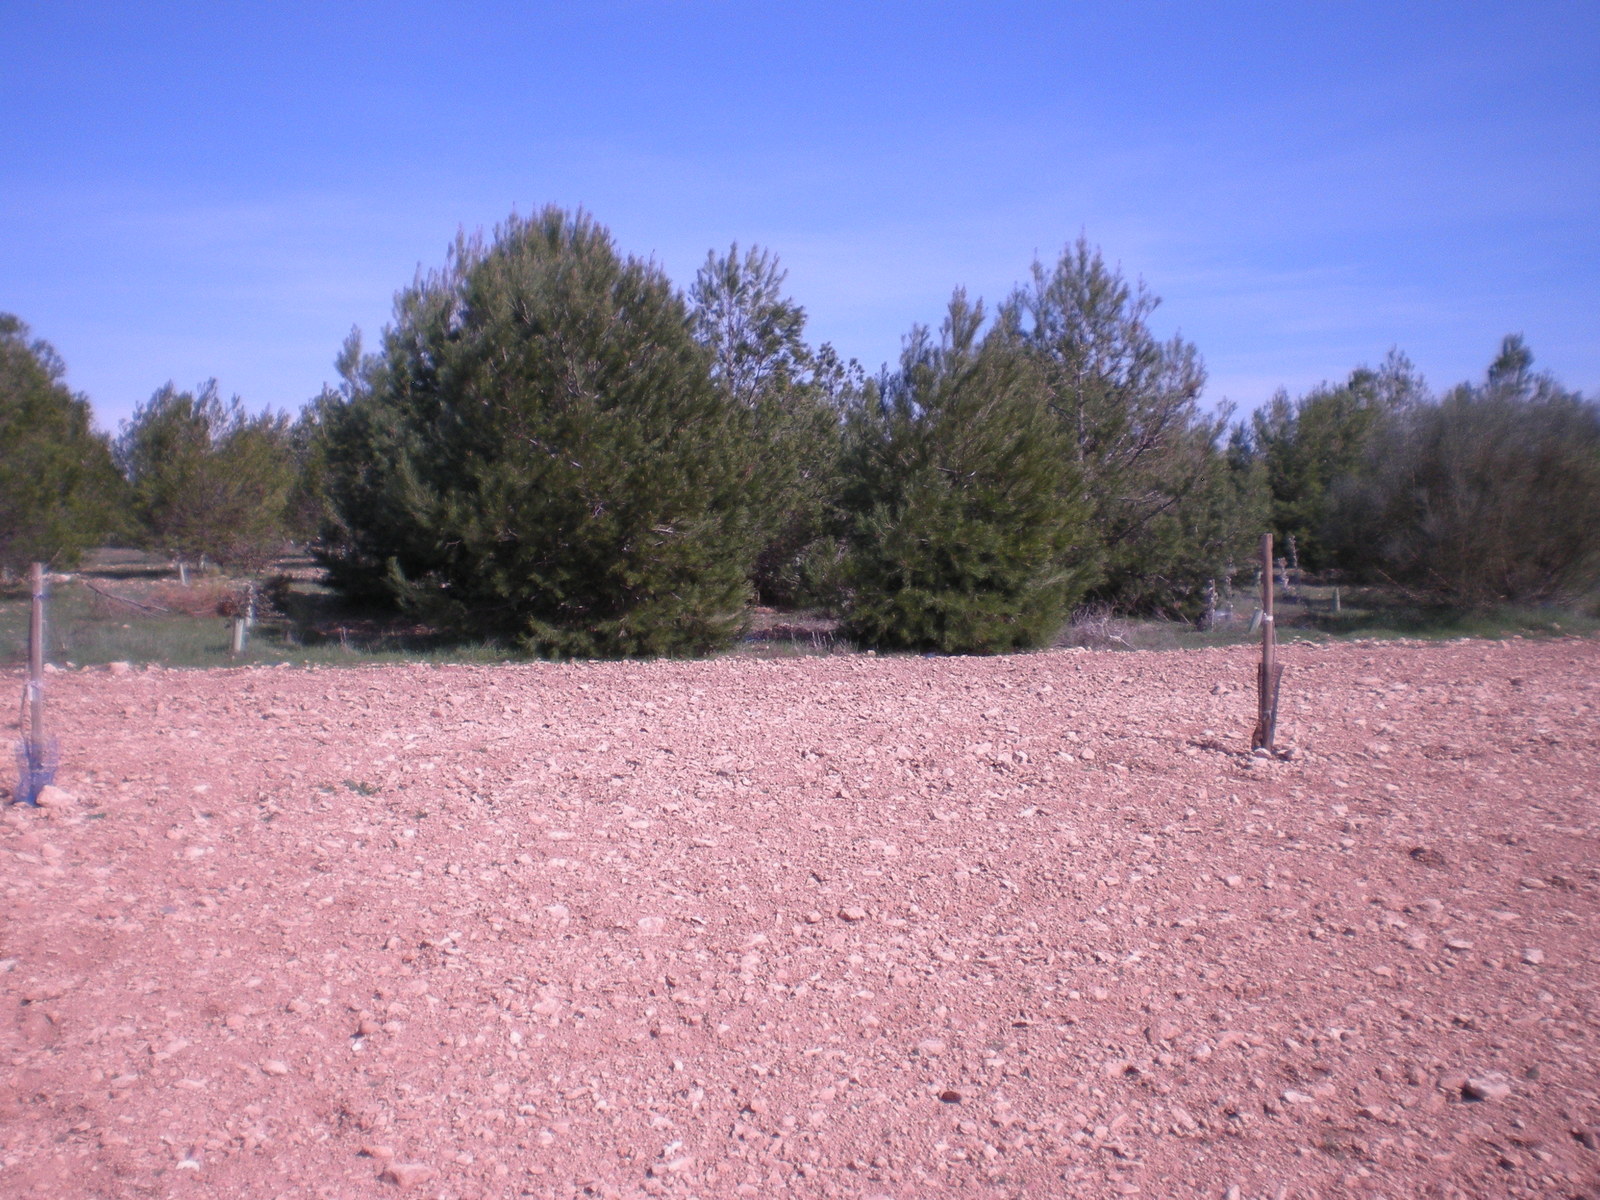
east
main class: Cropland
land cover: Nuts trees
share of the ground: < 10 %
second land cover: Other bare soil
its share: > 75 %
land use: Agriculture (excluding fallow land and kitchen gardens)
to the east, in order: Nuts trees; Other bare soil; Pine dominated coniferous woodland; Grass margins; Dry stone walls; Grass margins; Tracks; Grass margins; Vineyards
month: March
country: ES
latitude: 39.0600
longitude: -3.1991
